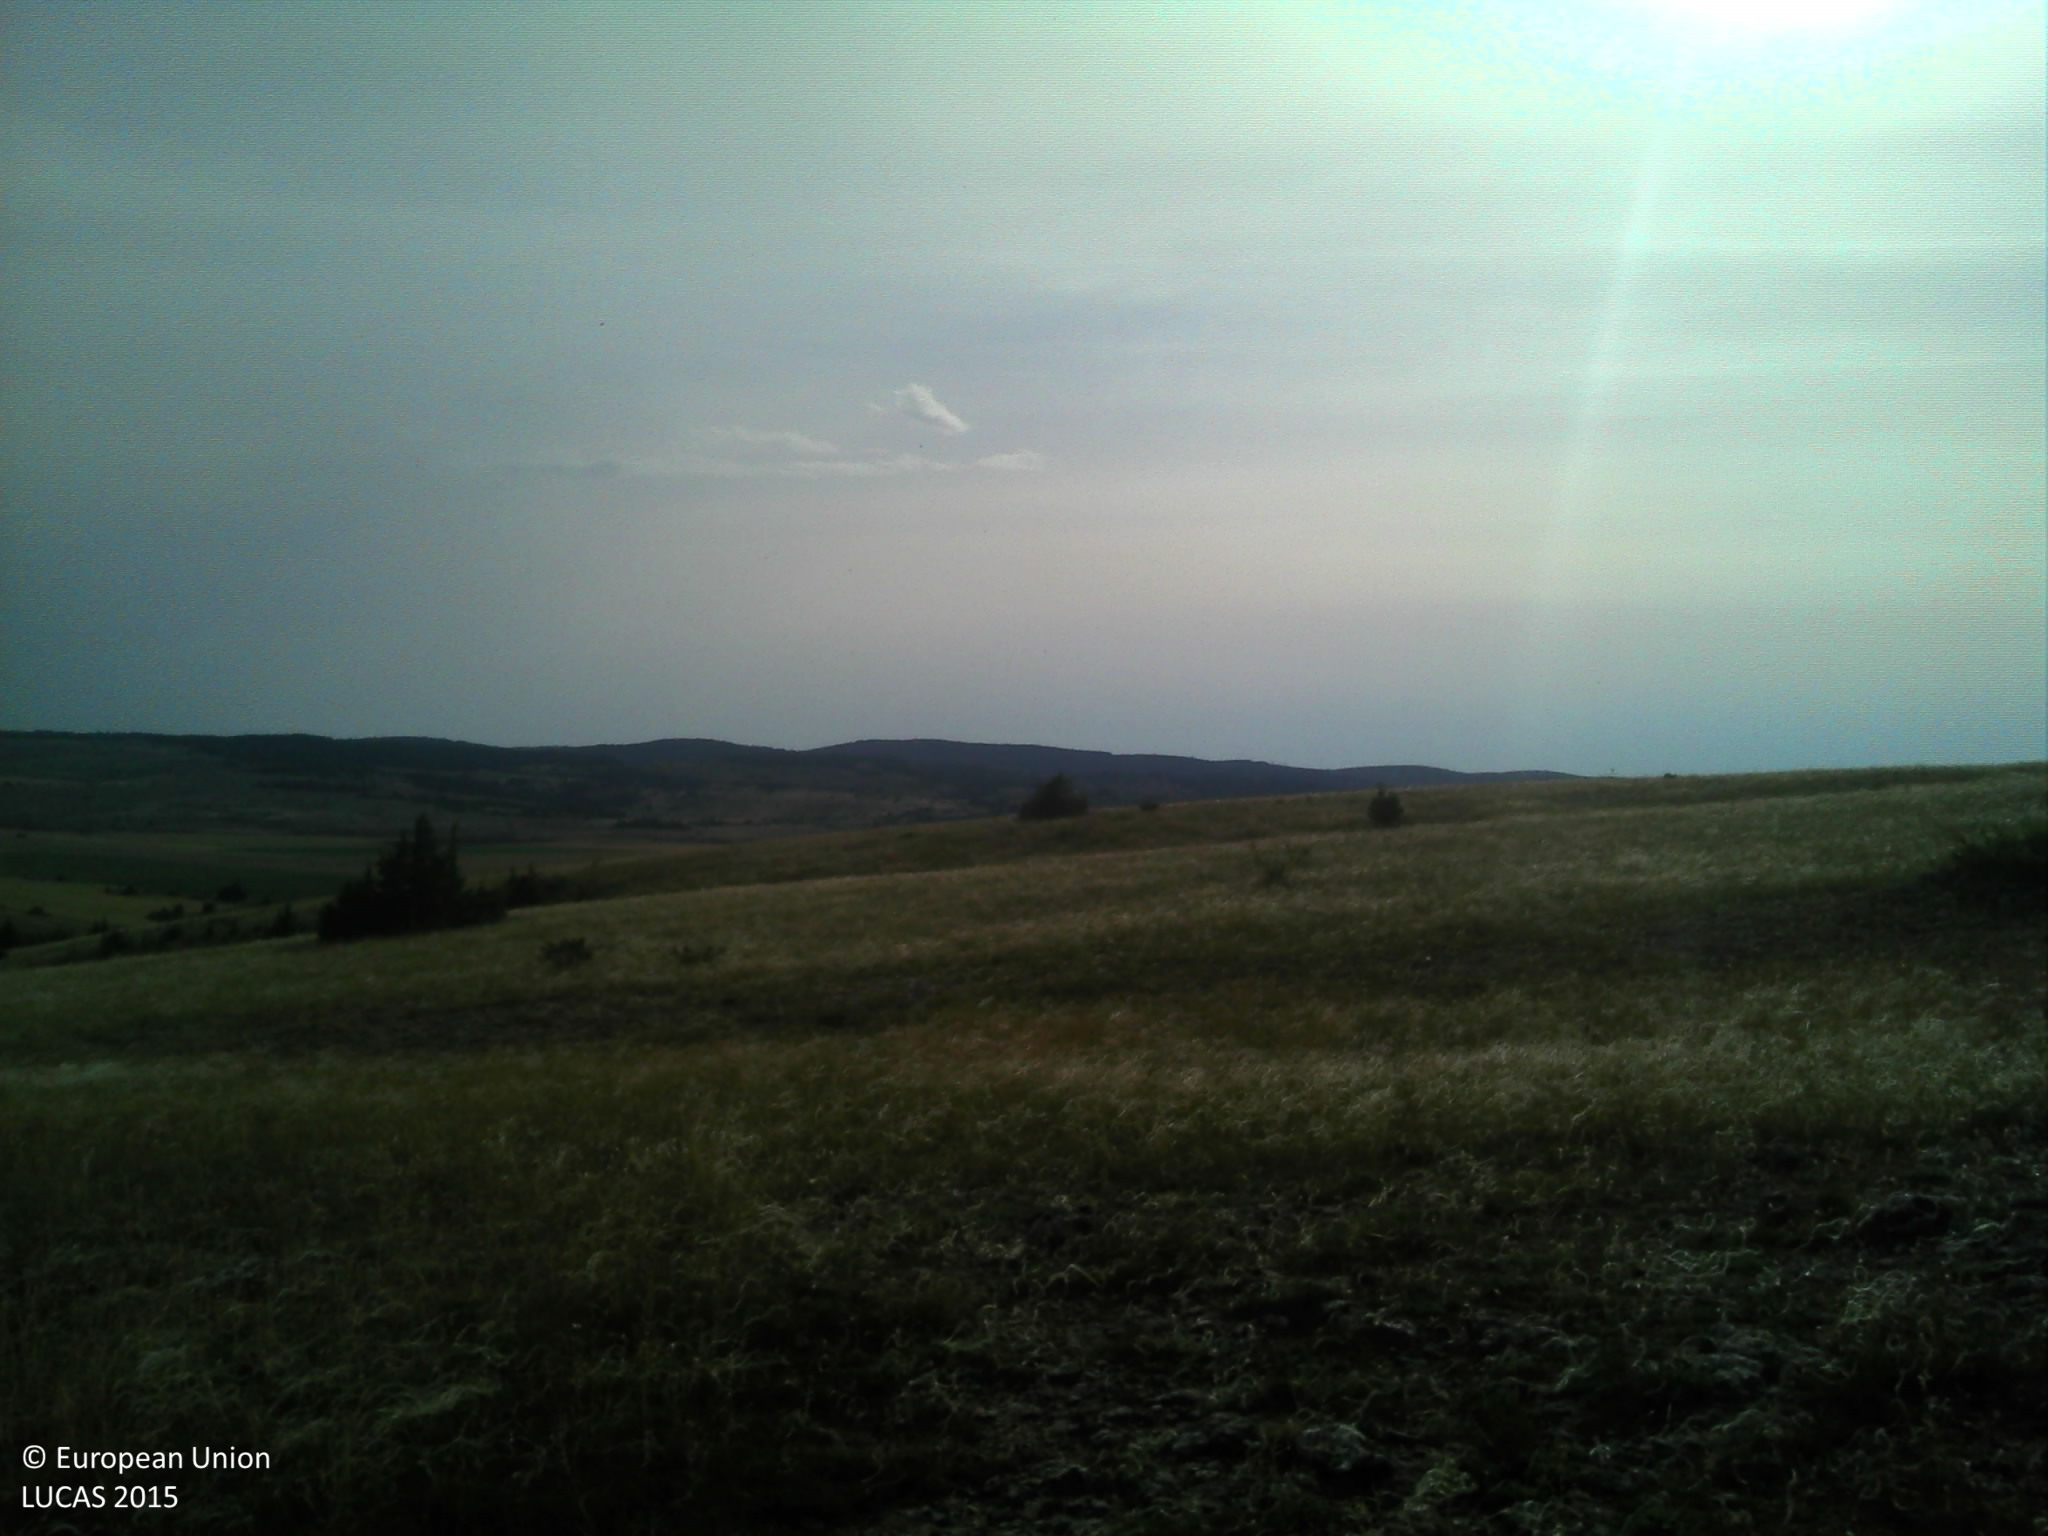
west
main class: Grassland
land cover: Grassland with sparse tree/shrub cover
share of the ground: > 75 %
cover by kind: herbaceous plants 80 %, coniferous forest trees 5 %, shrubs 5 %, unconsolidated bare surface 5 %
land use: Agriculture (excluding fallow land and kitchen gardens)
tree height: < 5 m
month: July
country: FR
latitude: 44.2899
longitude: 3.4768
